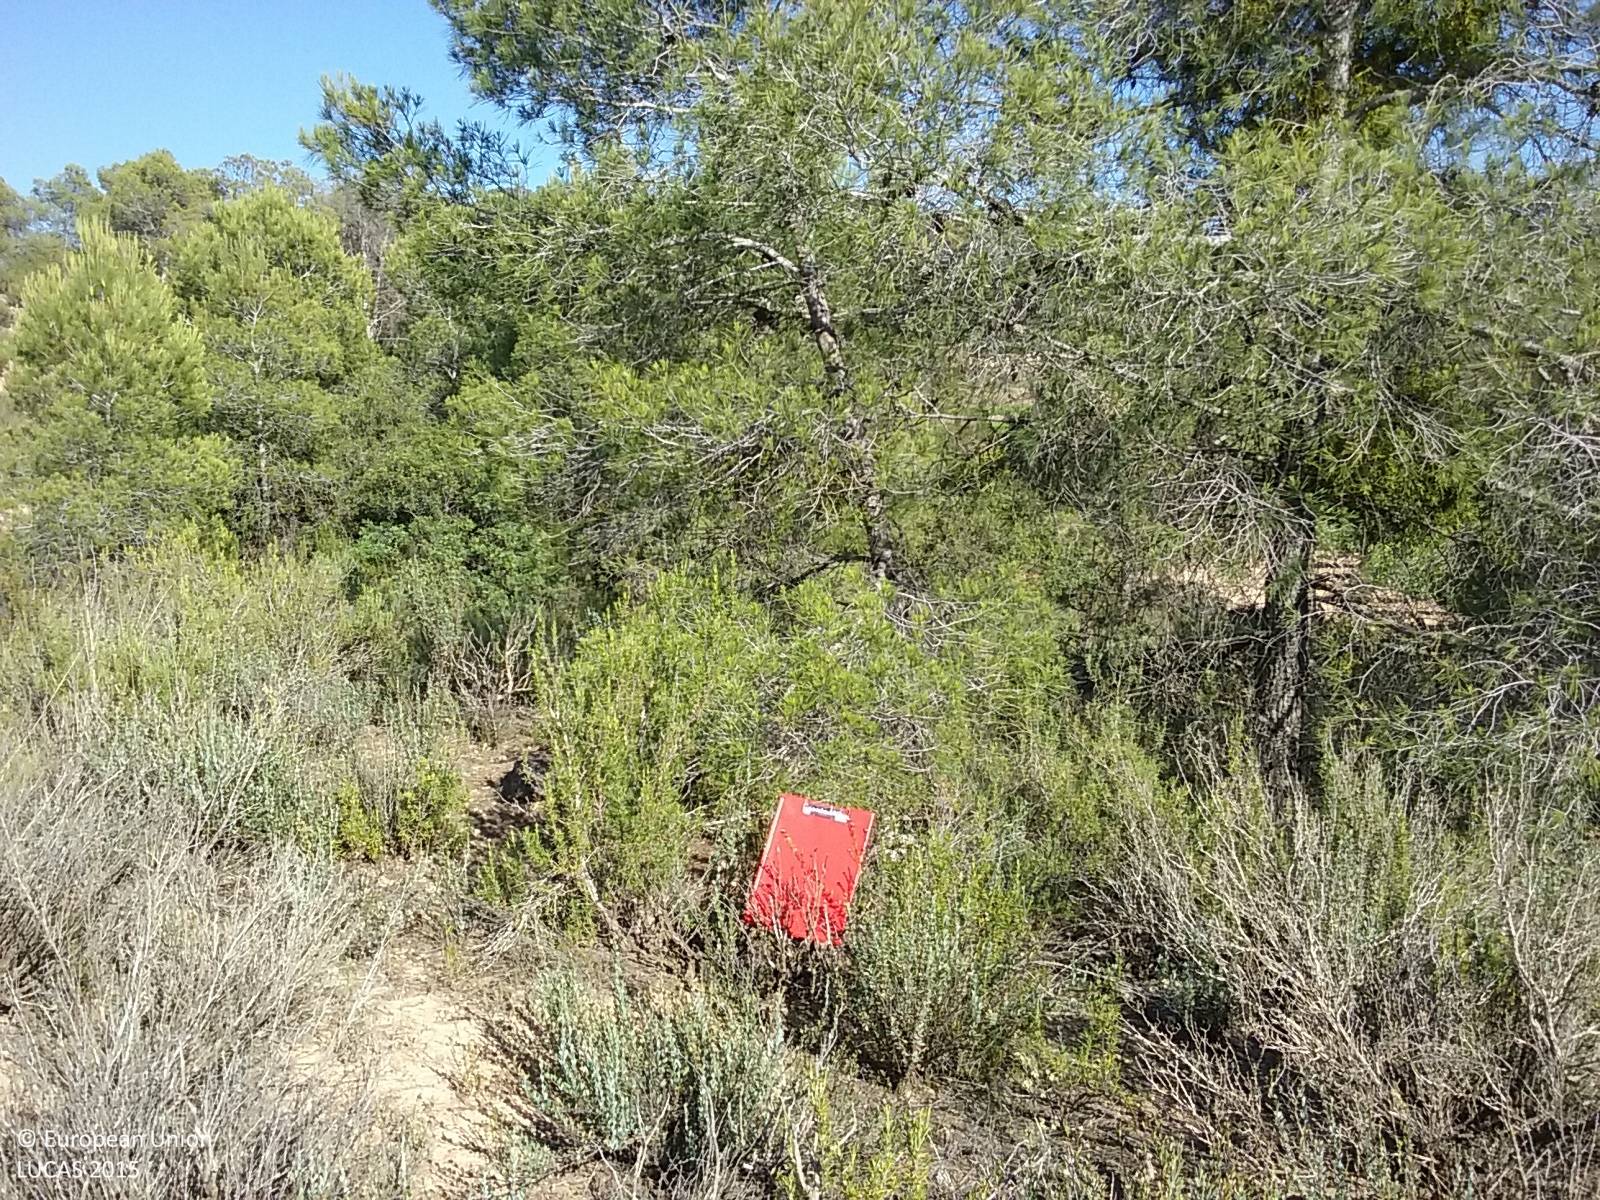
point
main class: Woodland
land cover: Pine dominated coniferous woodland
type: coniferous forest of the mediterranean region
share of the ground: 10 - 25 %
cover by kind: shrubs 65 %, coniferous forest trees 20 %, herbaceous plants 10 %, unconsolidated bare surface 5 %
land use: Semi-natural and natural areas not in use
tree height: > 5 m
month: June
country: ES
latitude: 41.0904
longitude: 0.2402
